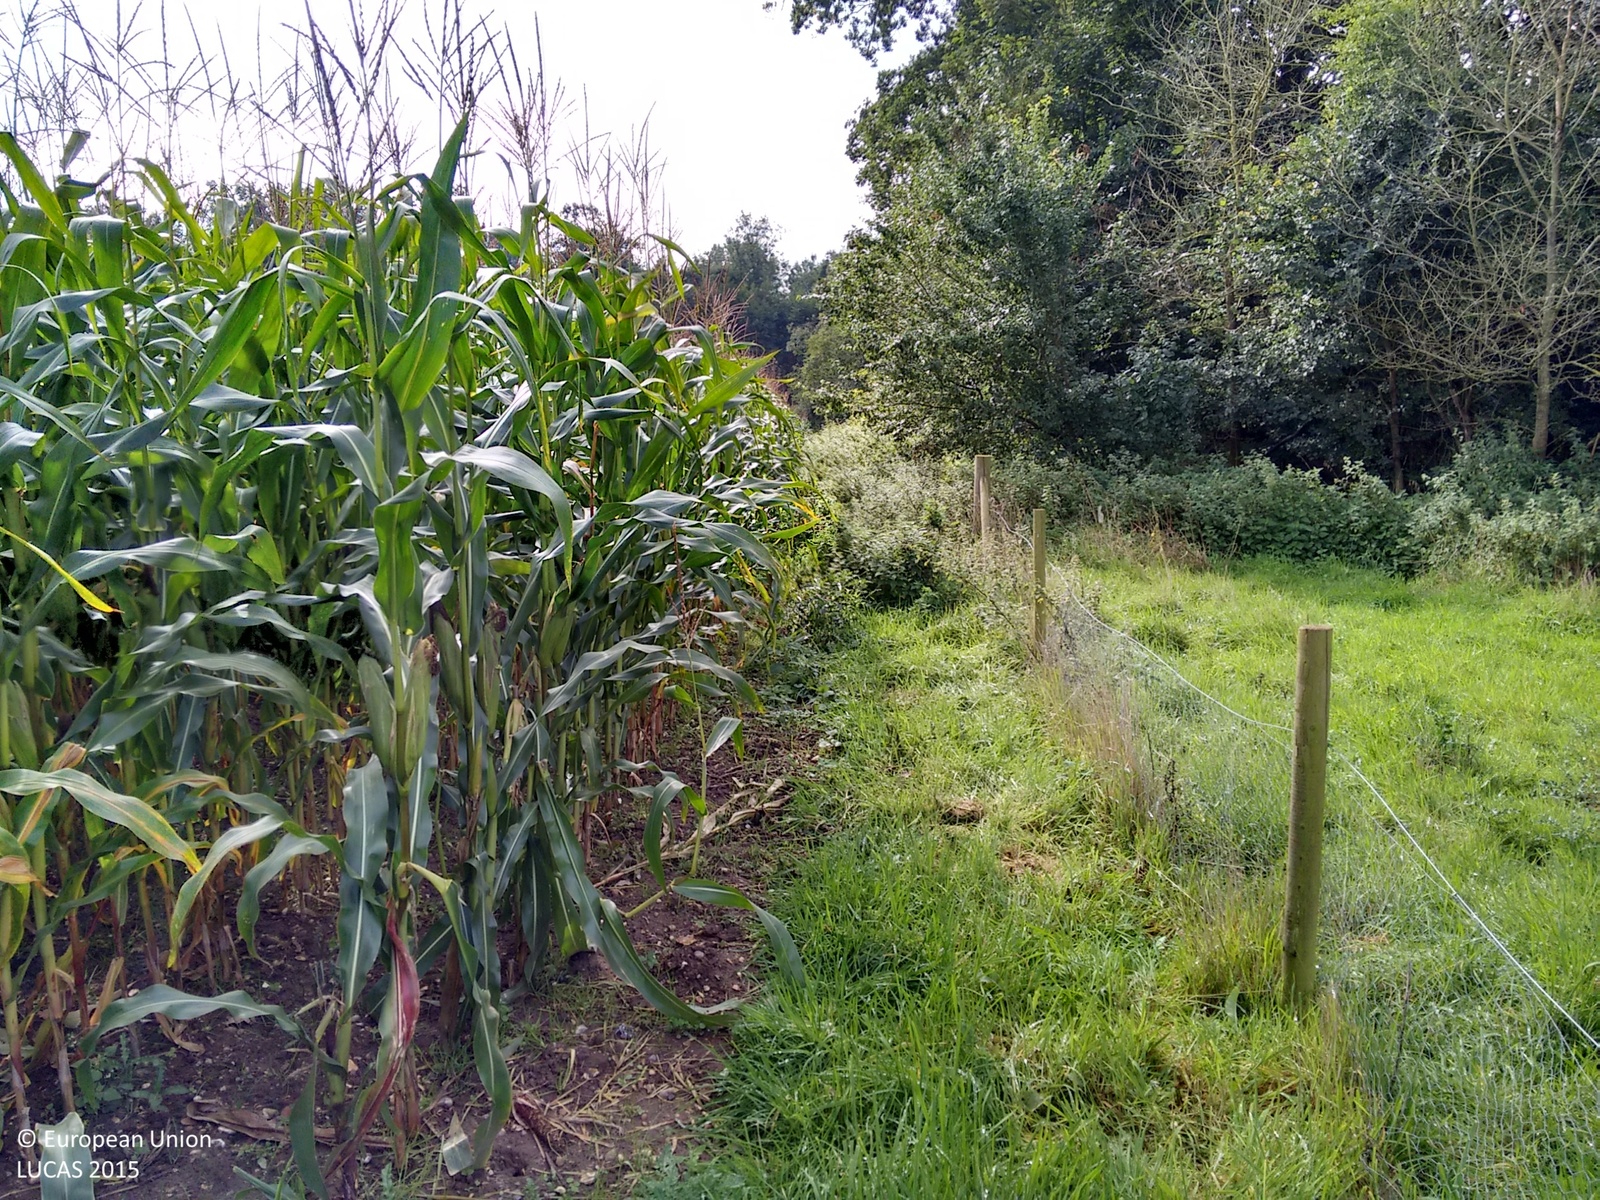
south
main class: Woodland
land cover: Broadleaved woodland
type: mesophytic deciduous forest
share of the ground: > 75 %
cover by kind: broadleaved forest trees 100 %
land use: Forestry
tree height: > 5 m
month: September
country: GB
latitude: 52.5404
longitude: 1.4733
